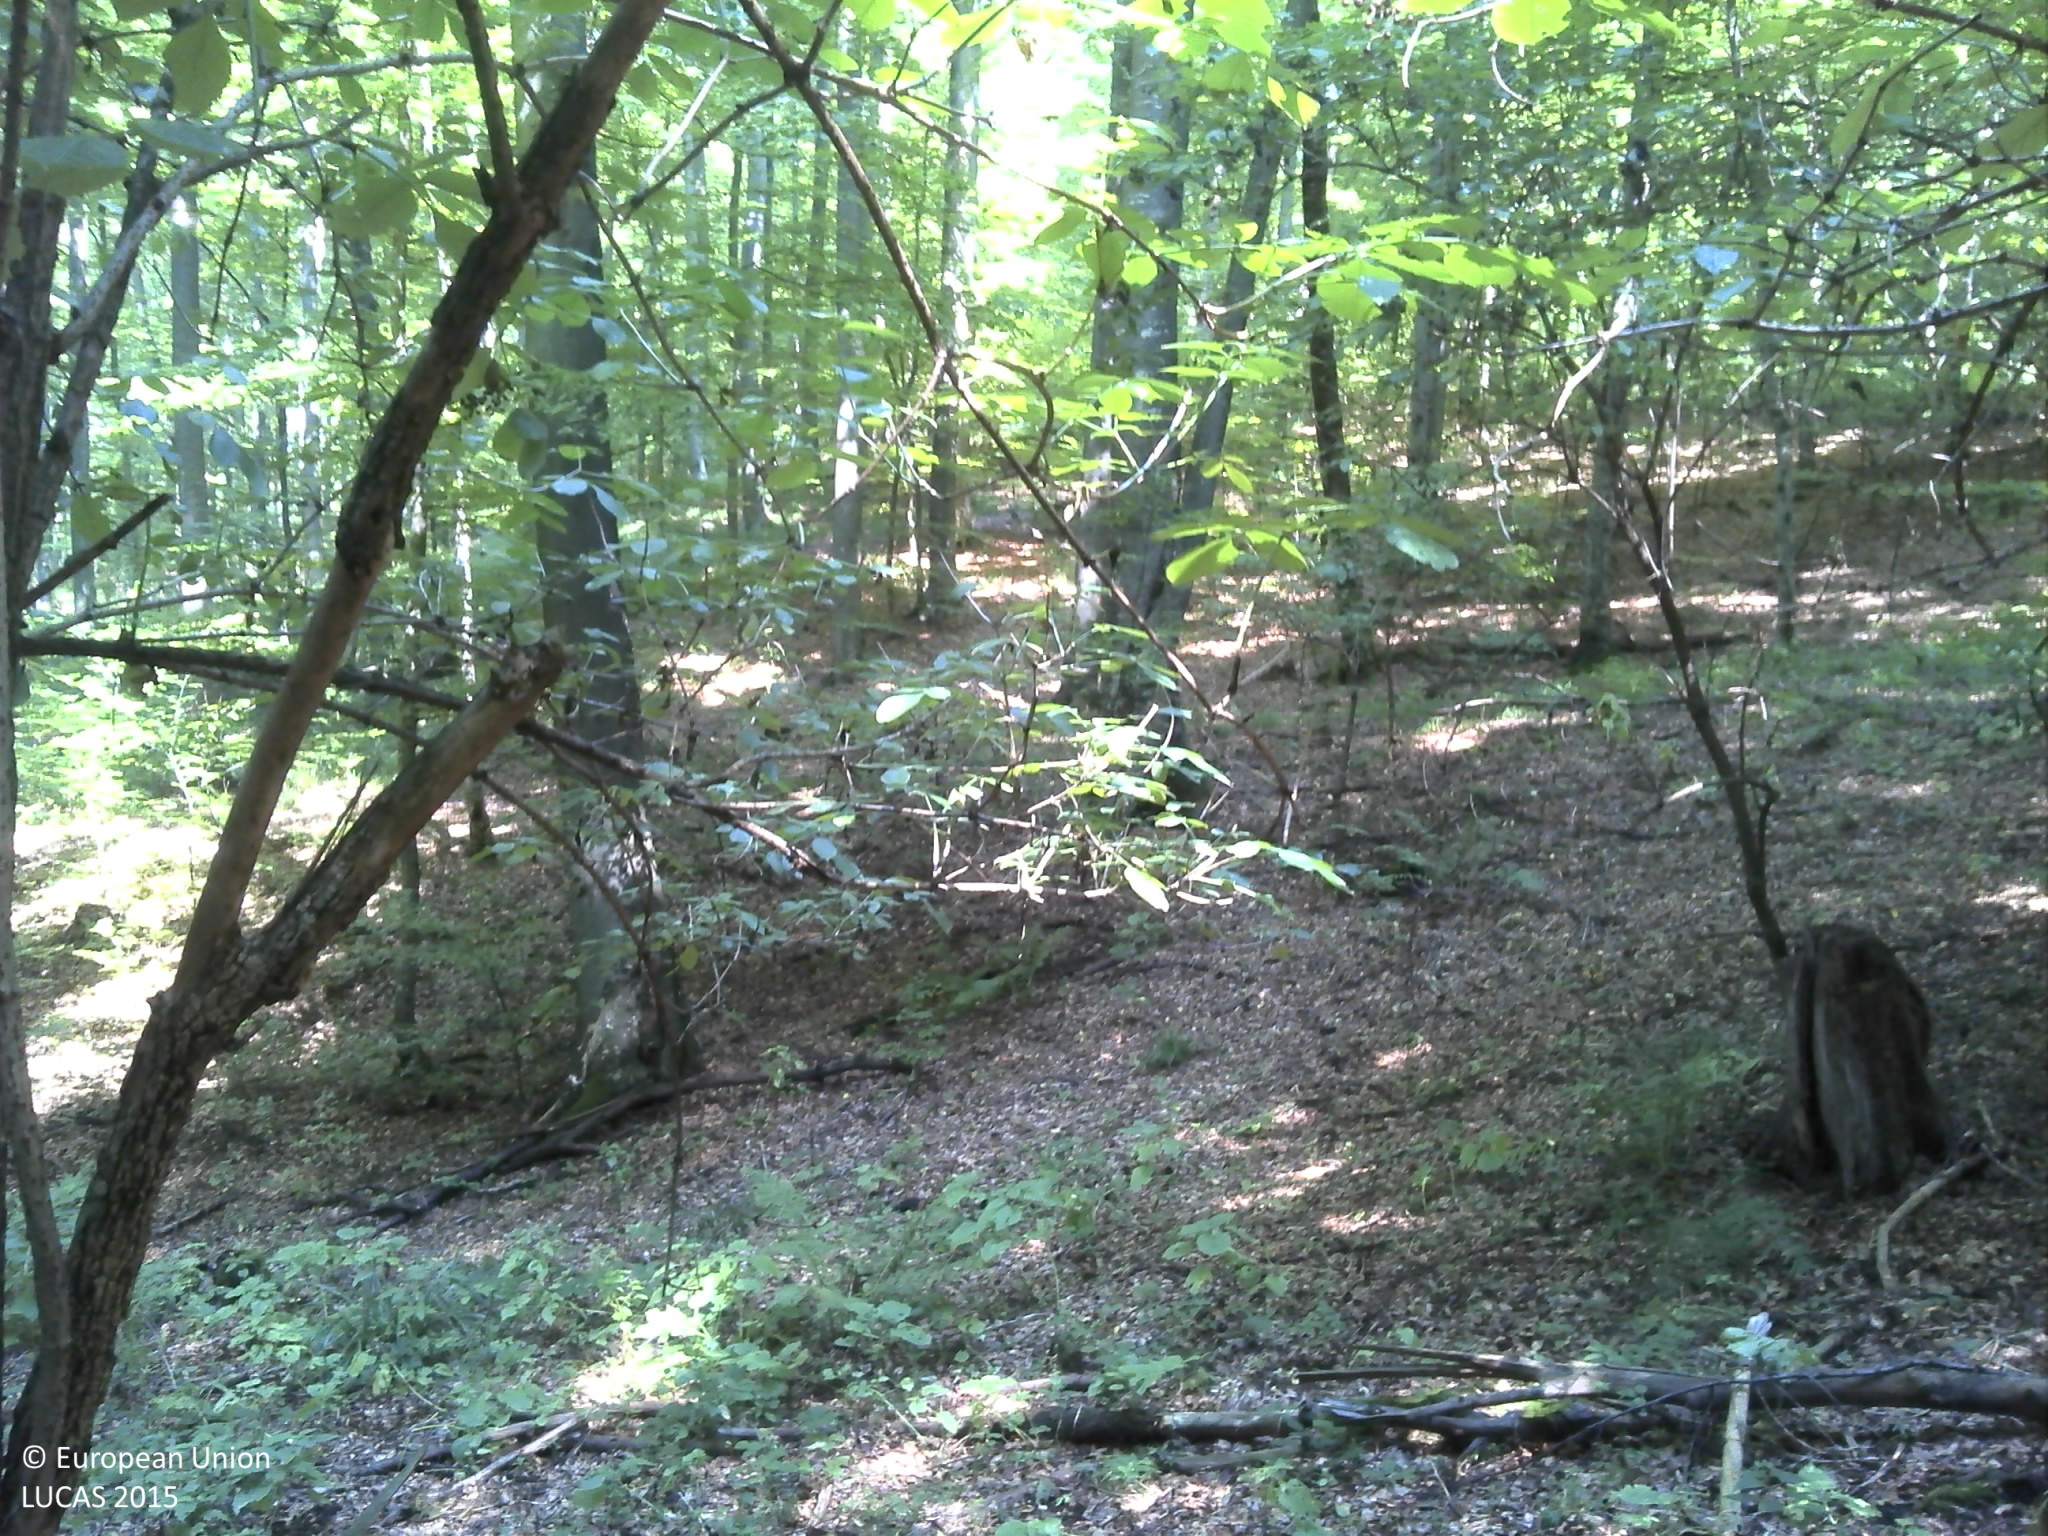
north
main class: Woodland
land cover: Broadleaved woodland
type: beech forest
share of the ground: > 75 %
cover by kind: broadleaved forest trees 100 %
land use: Forestry
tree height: > 5 m
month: August
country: HR
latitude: 45.2437
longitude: 16.3032
